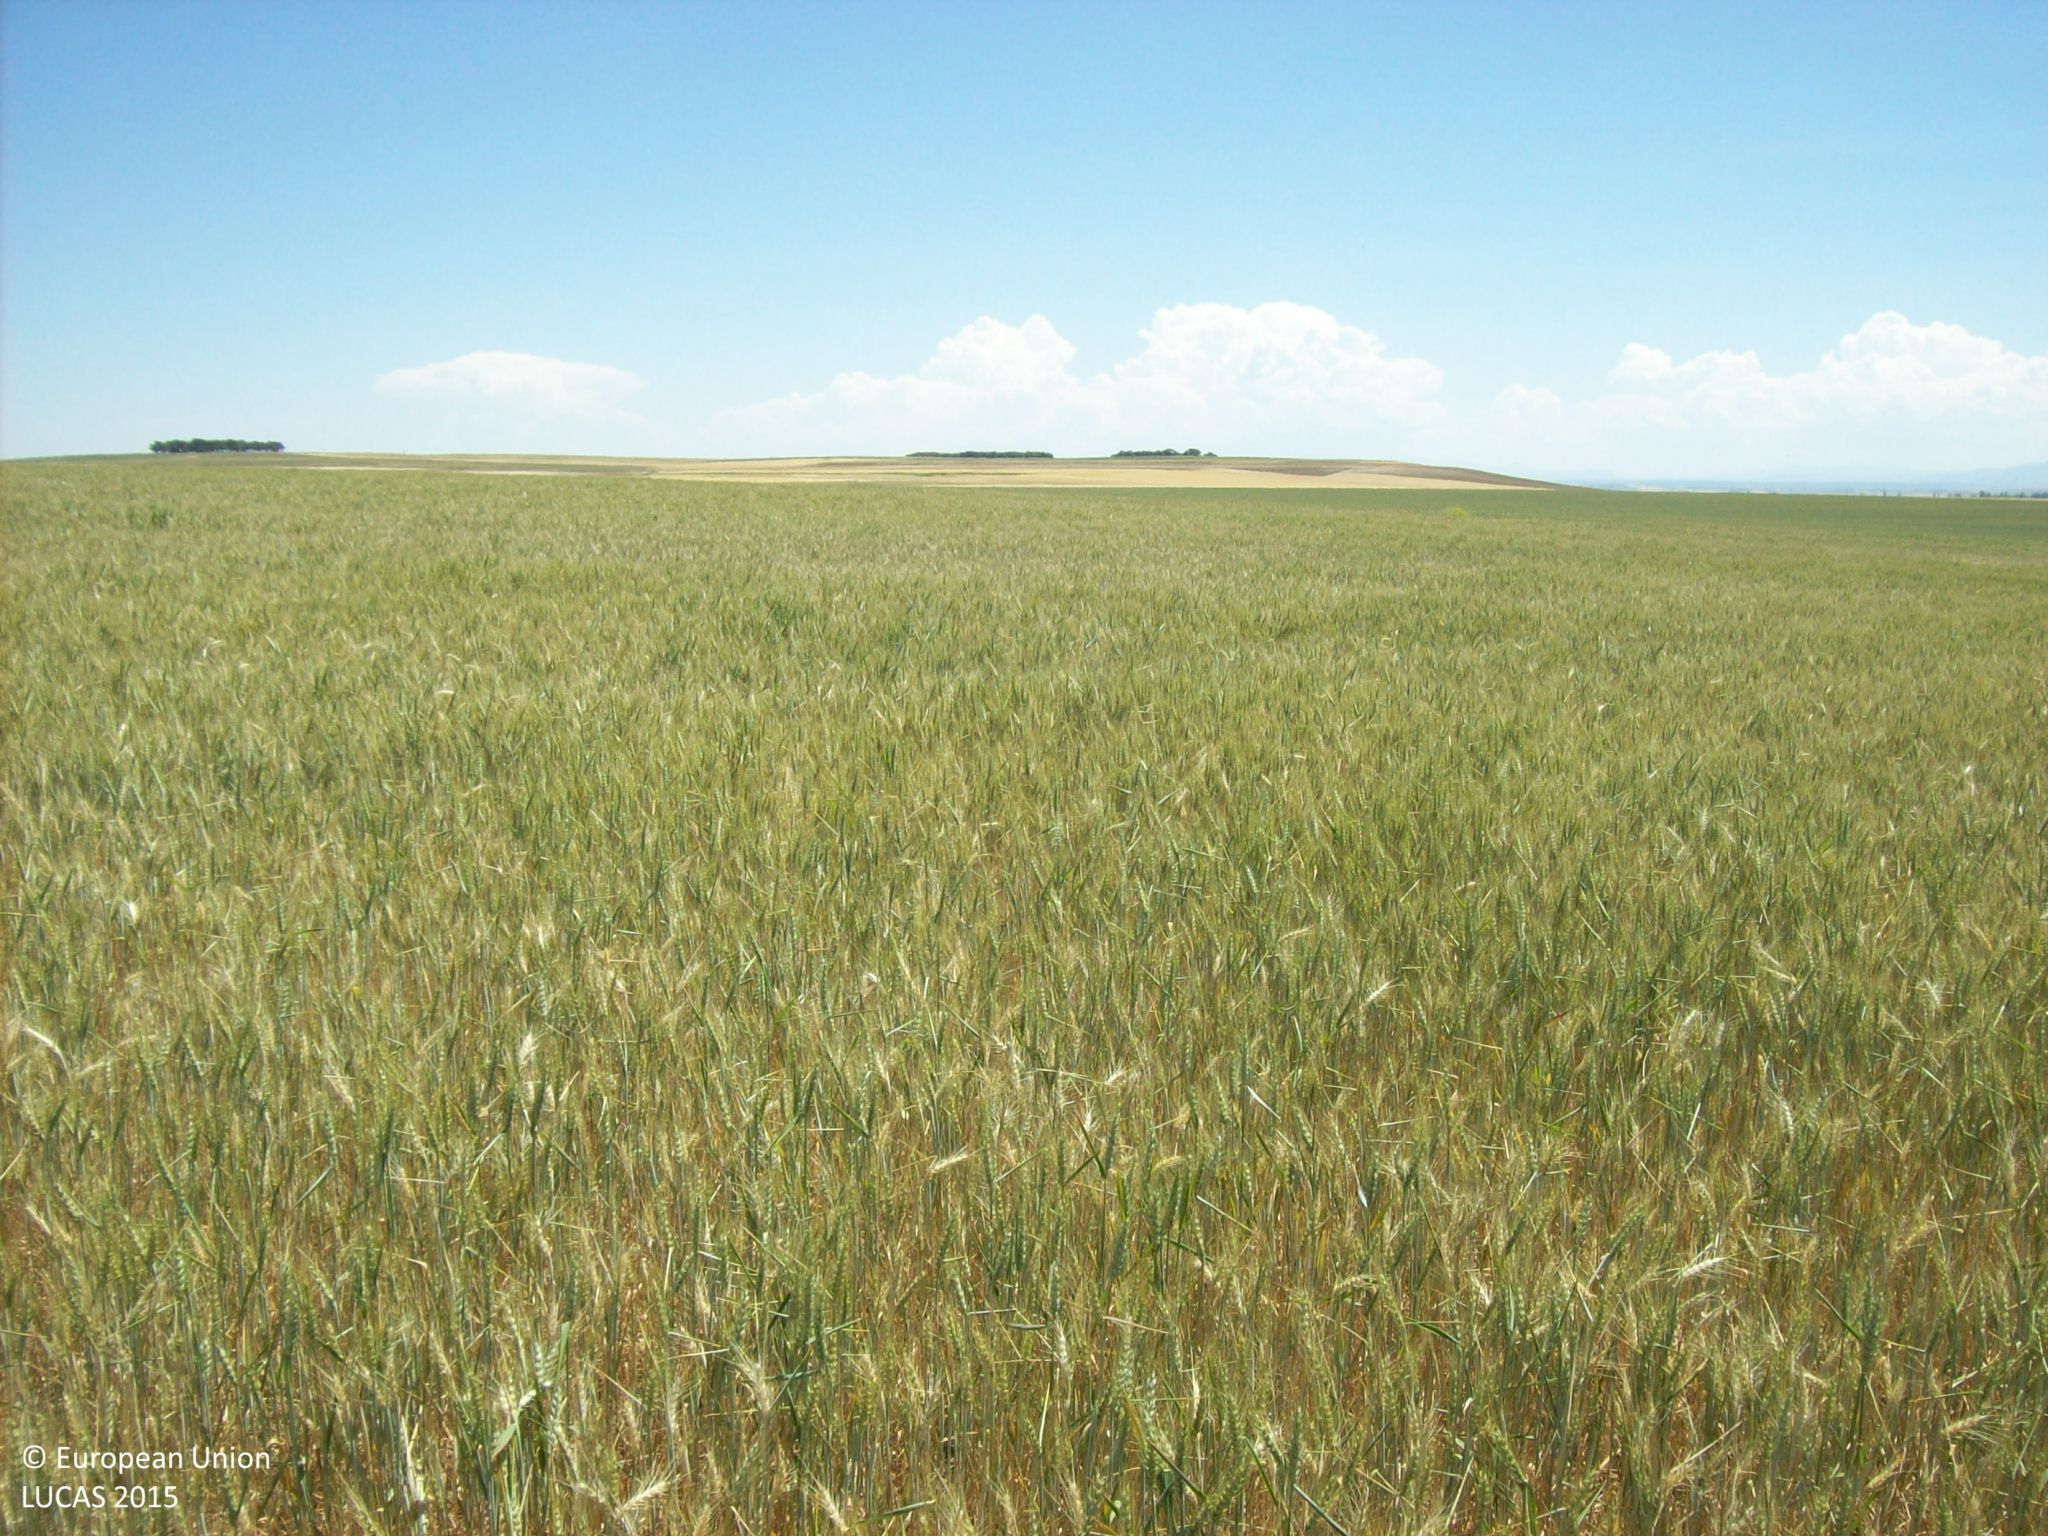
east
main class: Cropland
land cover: Common wheat
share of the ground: > 75 %
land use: Agriculture (excluding fallow land and kitchen gardens)
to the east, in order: Common wheat; Grass margins; Tracks; Grass margins; Common wheat
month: May
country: ES
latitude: 40.8797
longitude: -4.9318
